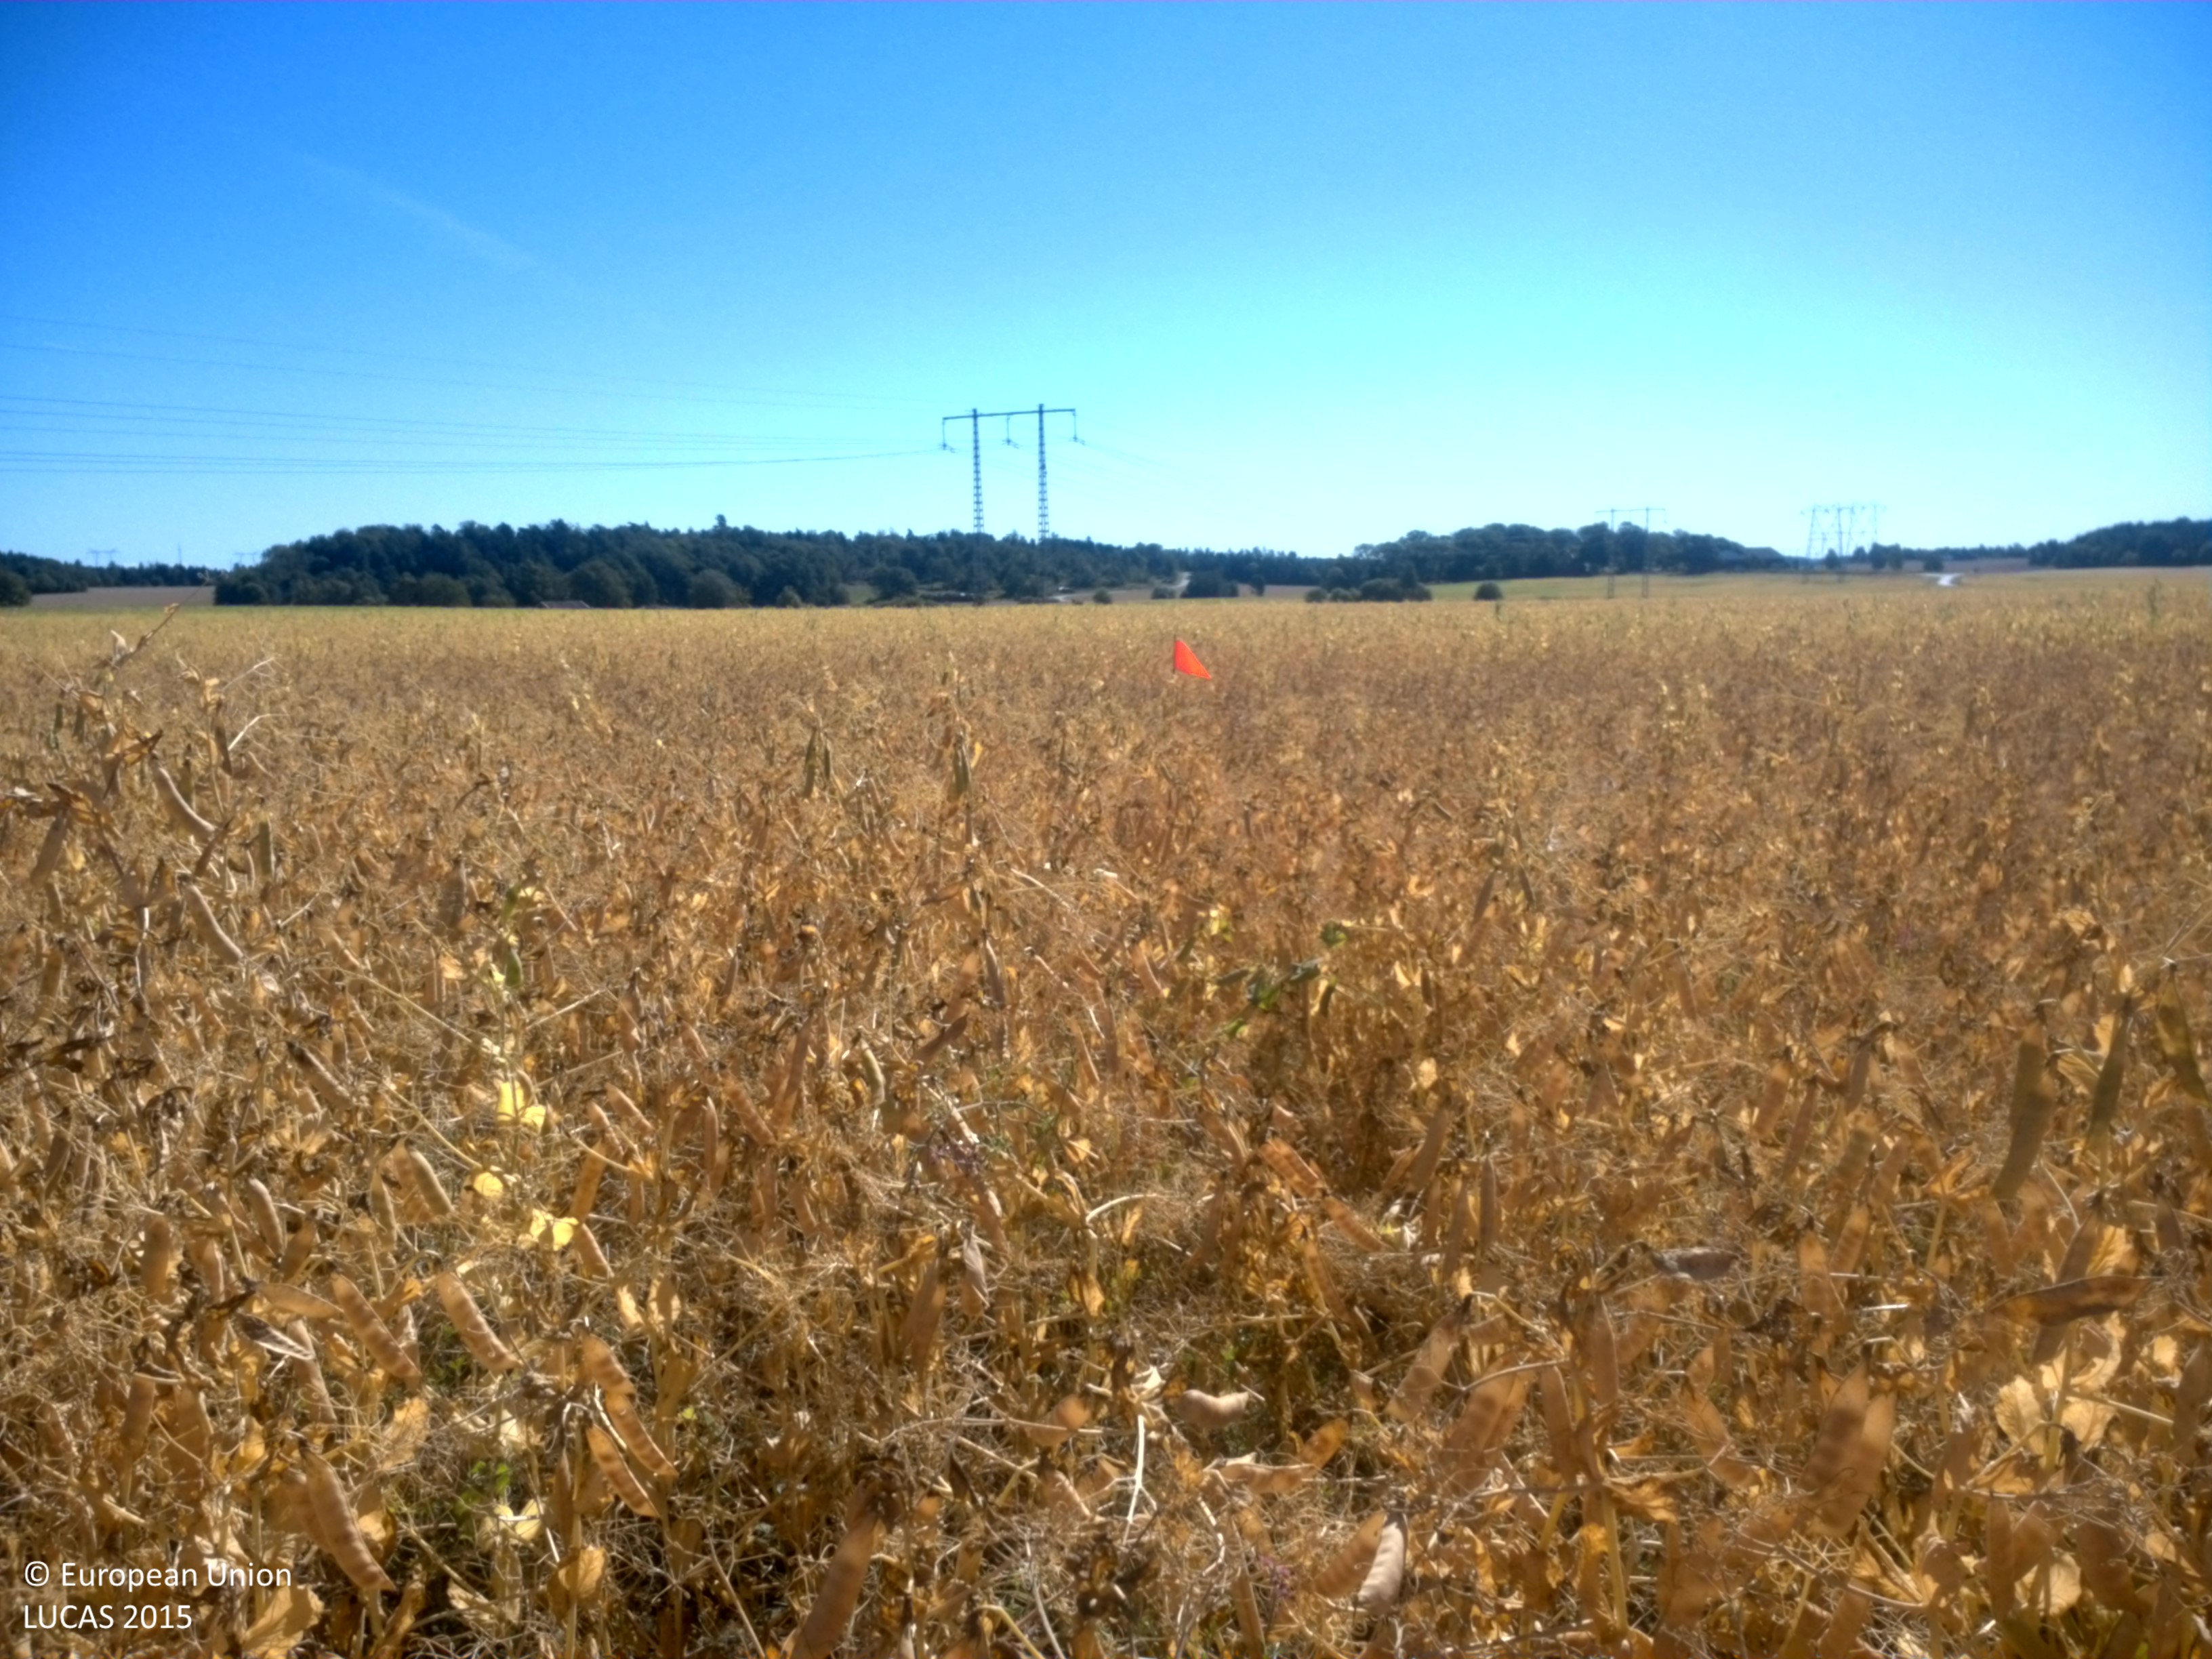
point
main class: Cropland
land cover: Dry pulses
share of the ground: > 75 %
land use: Agriculture (excluding fallow land and kitchen gardens)
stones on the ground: < 10 %
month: August
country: SE
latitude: 59.7239
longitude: 17.2309
